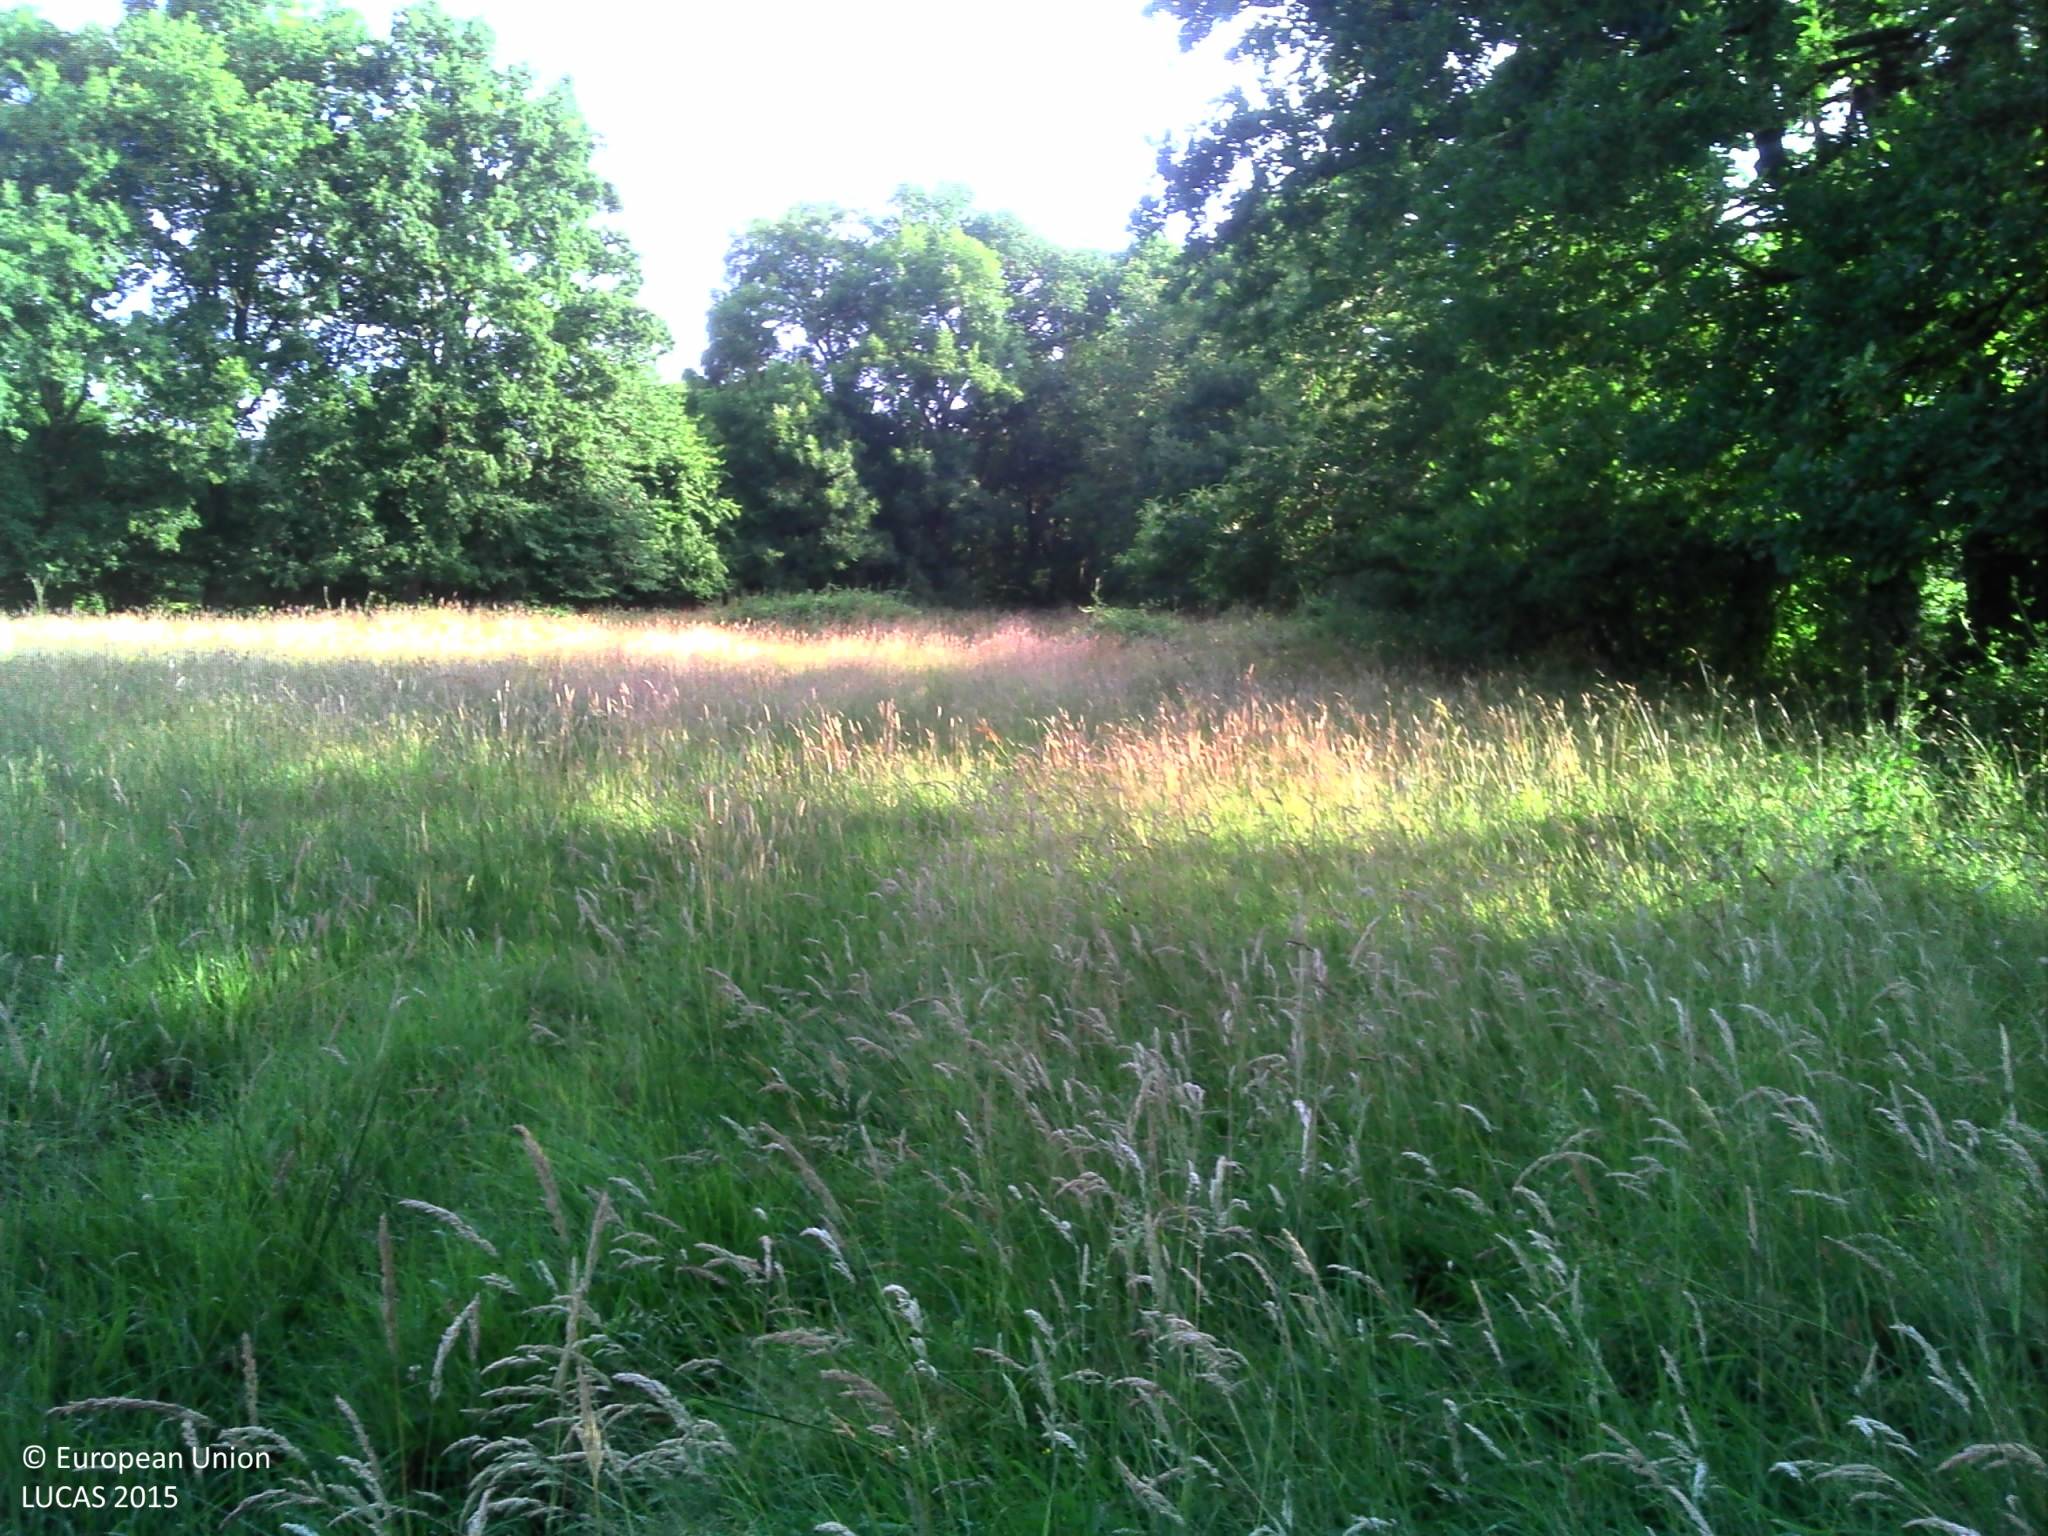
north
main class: Grassland
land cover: Grassland without tree/shrub cover
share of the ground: > 75 %
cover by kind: herbaceous plants 100 %
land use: Agriculture (excluding fallow land and kitchen gardens)
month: July
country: FR
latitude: 48.3563
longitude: -1.7507
